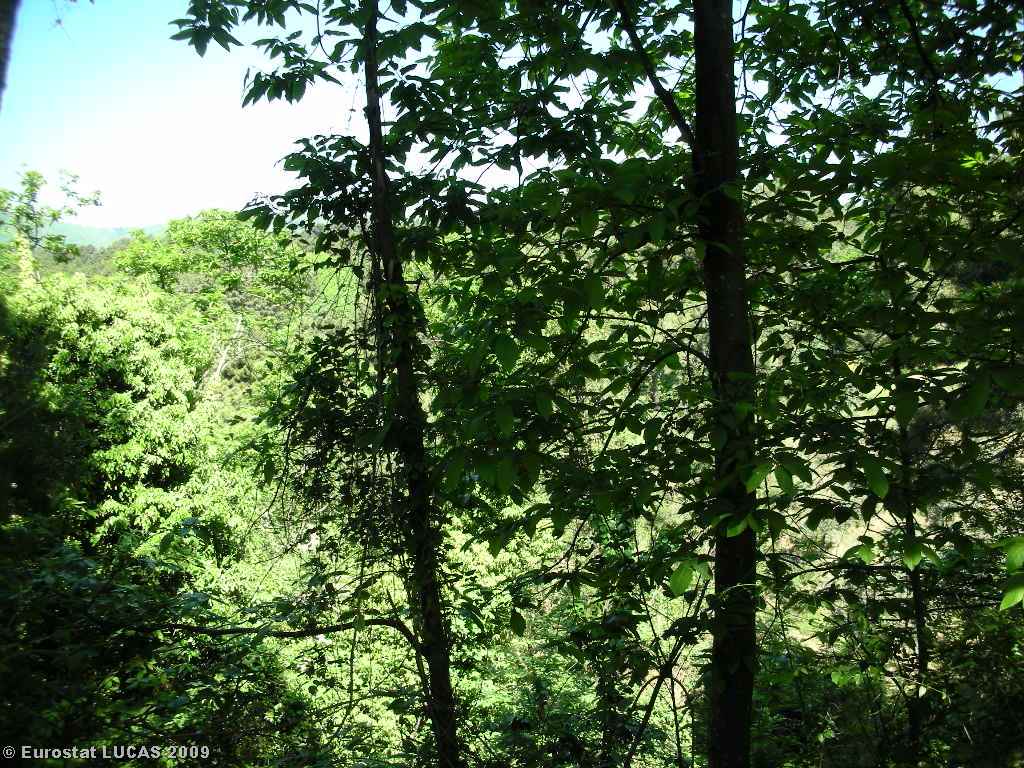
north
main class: Woodland
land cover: Mixed woodland
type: thermophilous deciduous forest
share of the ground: > 75 %
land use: Forestry
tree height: > 5 m
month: May
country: IT
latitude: 43.9325
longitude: 10.8076
